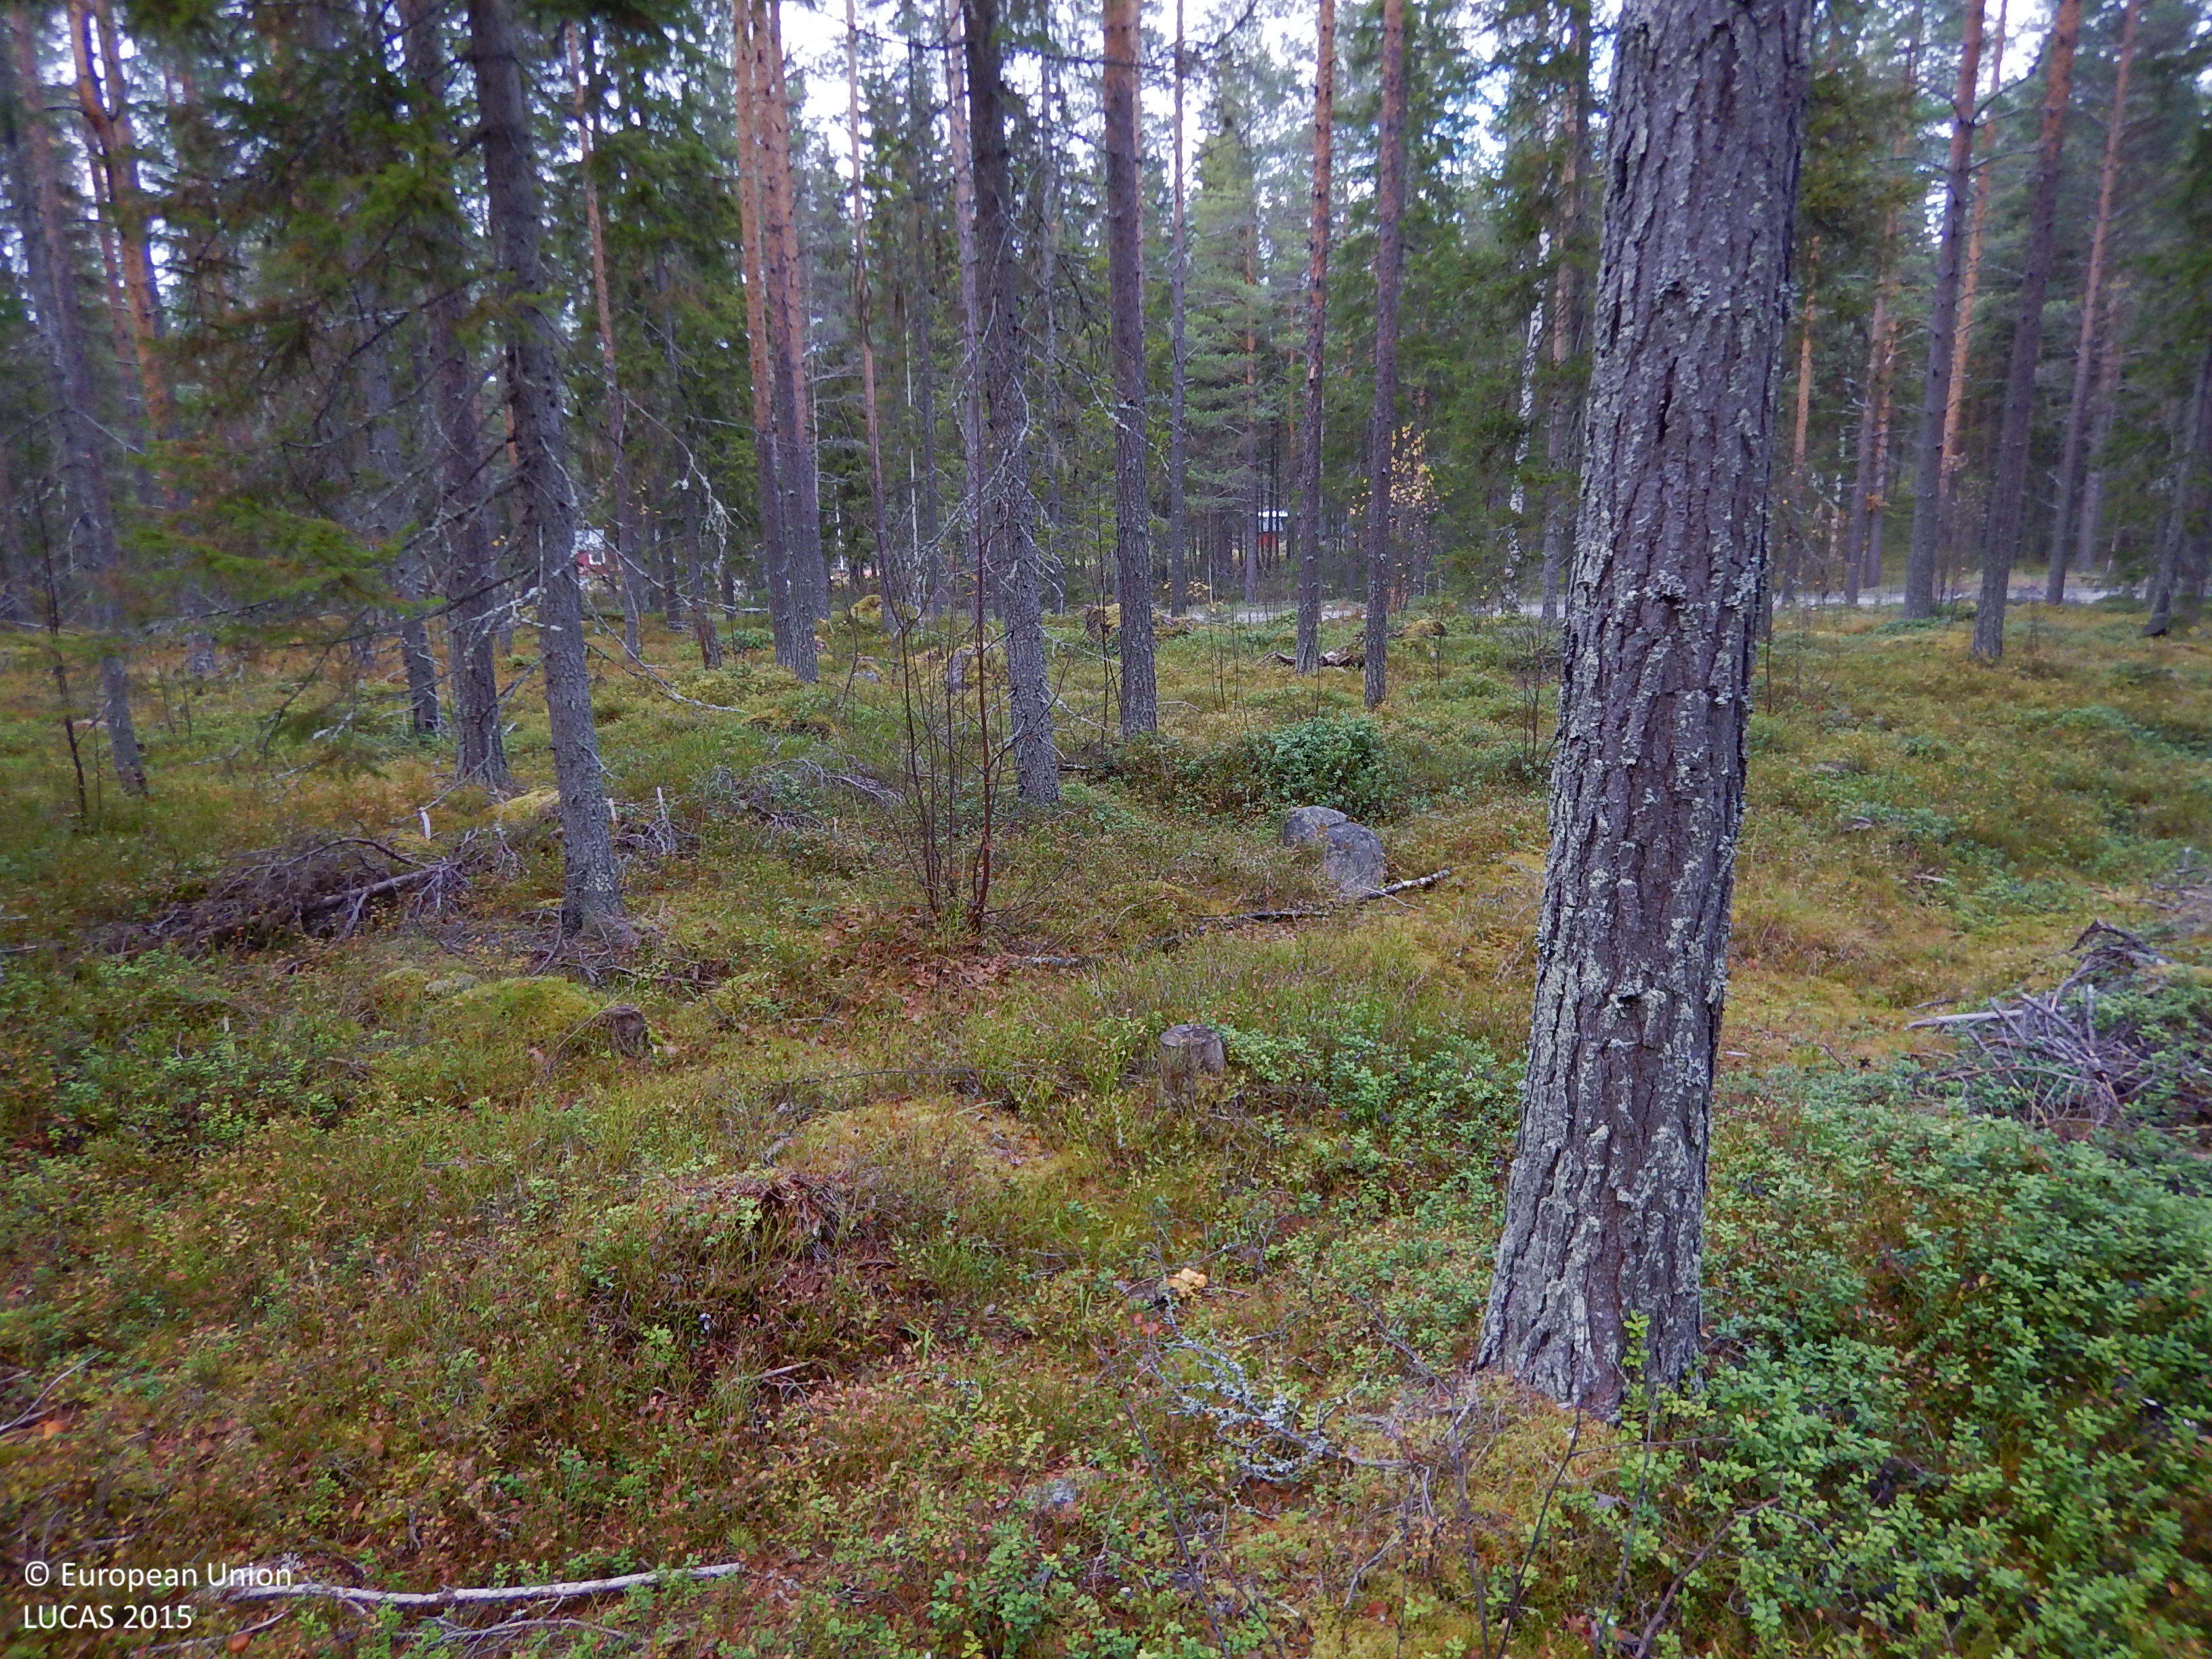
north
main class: Woodland
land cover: Pine dominated coniferous woodland
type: boreal forest
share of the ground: 50 - 75 %
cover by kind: coniferous forest trees 60 %, shrubs 20 %, lichens and mosses 10 %, broadleaved forest trees 5 %, herbaceous plants 5 %
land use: Forestry
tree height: > 5 m
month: October
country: SE
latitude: 65.1217
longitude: 21.1171
